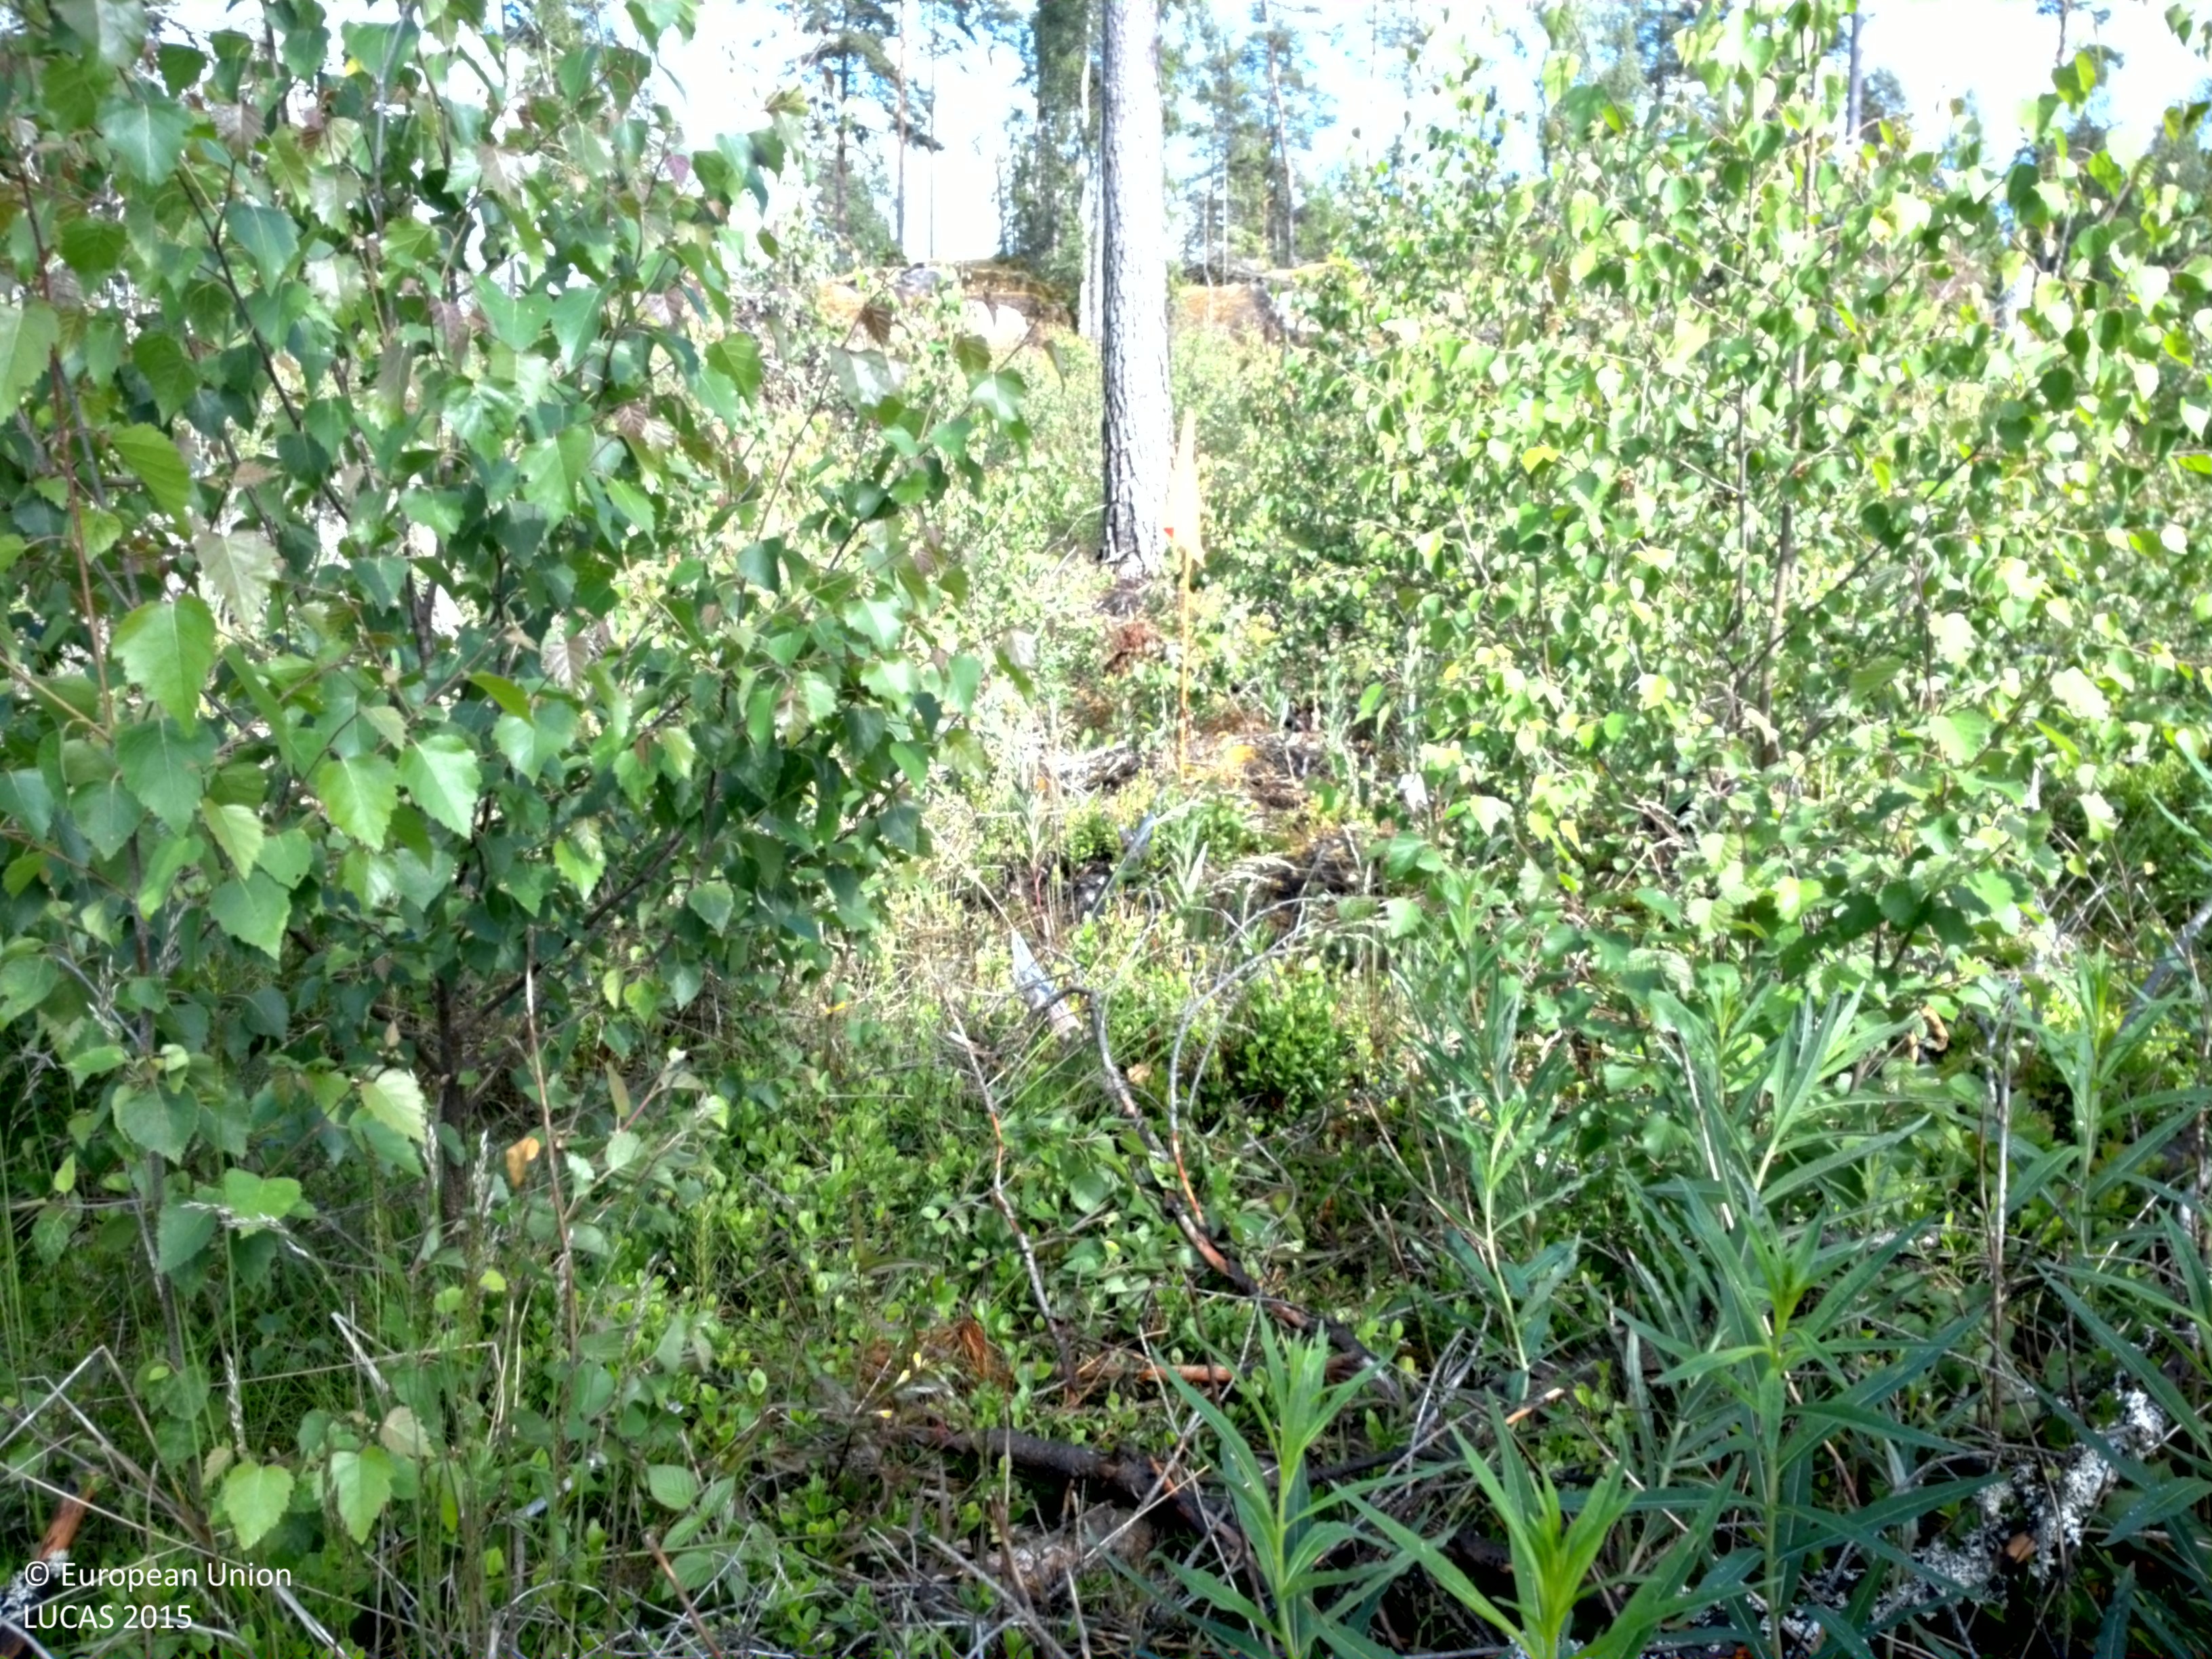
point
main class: Woodland
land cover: Broadleaved woodland
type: boreal forest
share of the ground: 10 - 25 %
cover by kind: lichens and mosses 55 %, broadleaved forest trees 20 %, herbaceous plants 20 %, coniferous forest trees 5 %
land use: Forestry
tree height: < 5 m
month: June
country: SE
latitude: 59.8957
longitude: 17.0525
